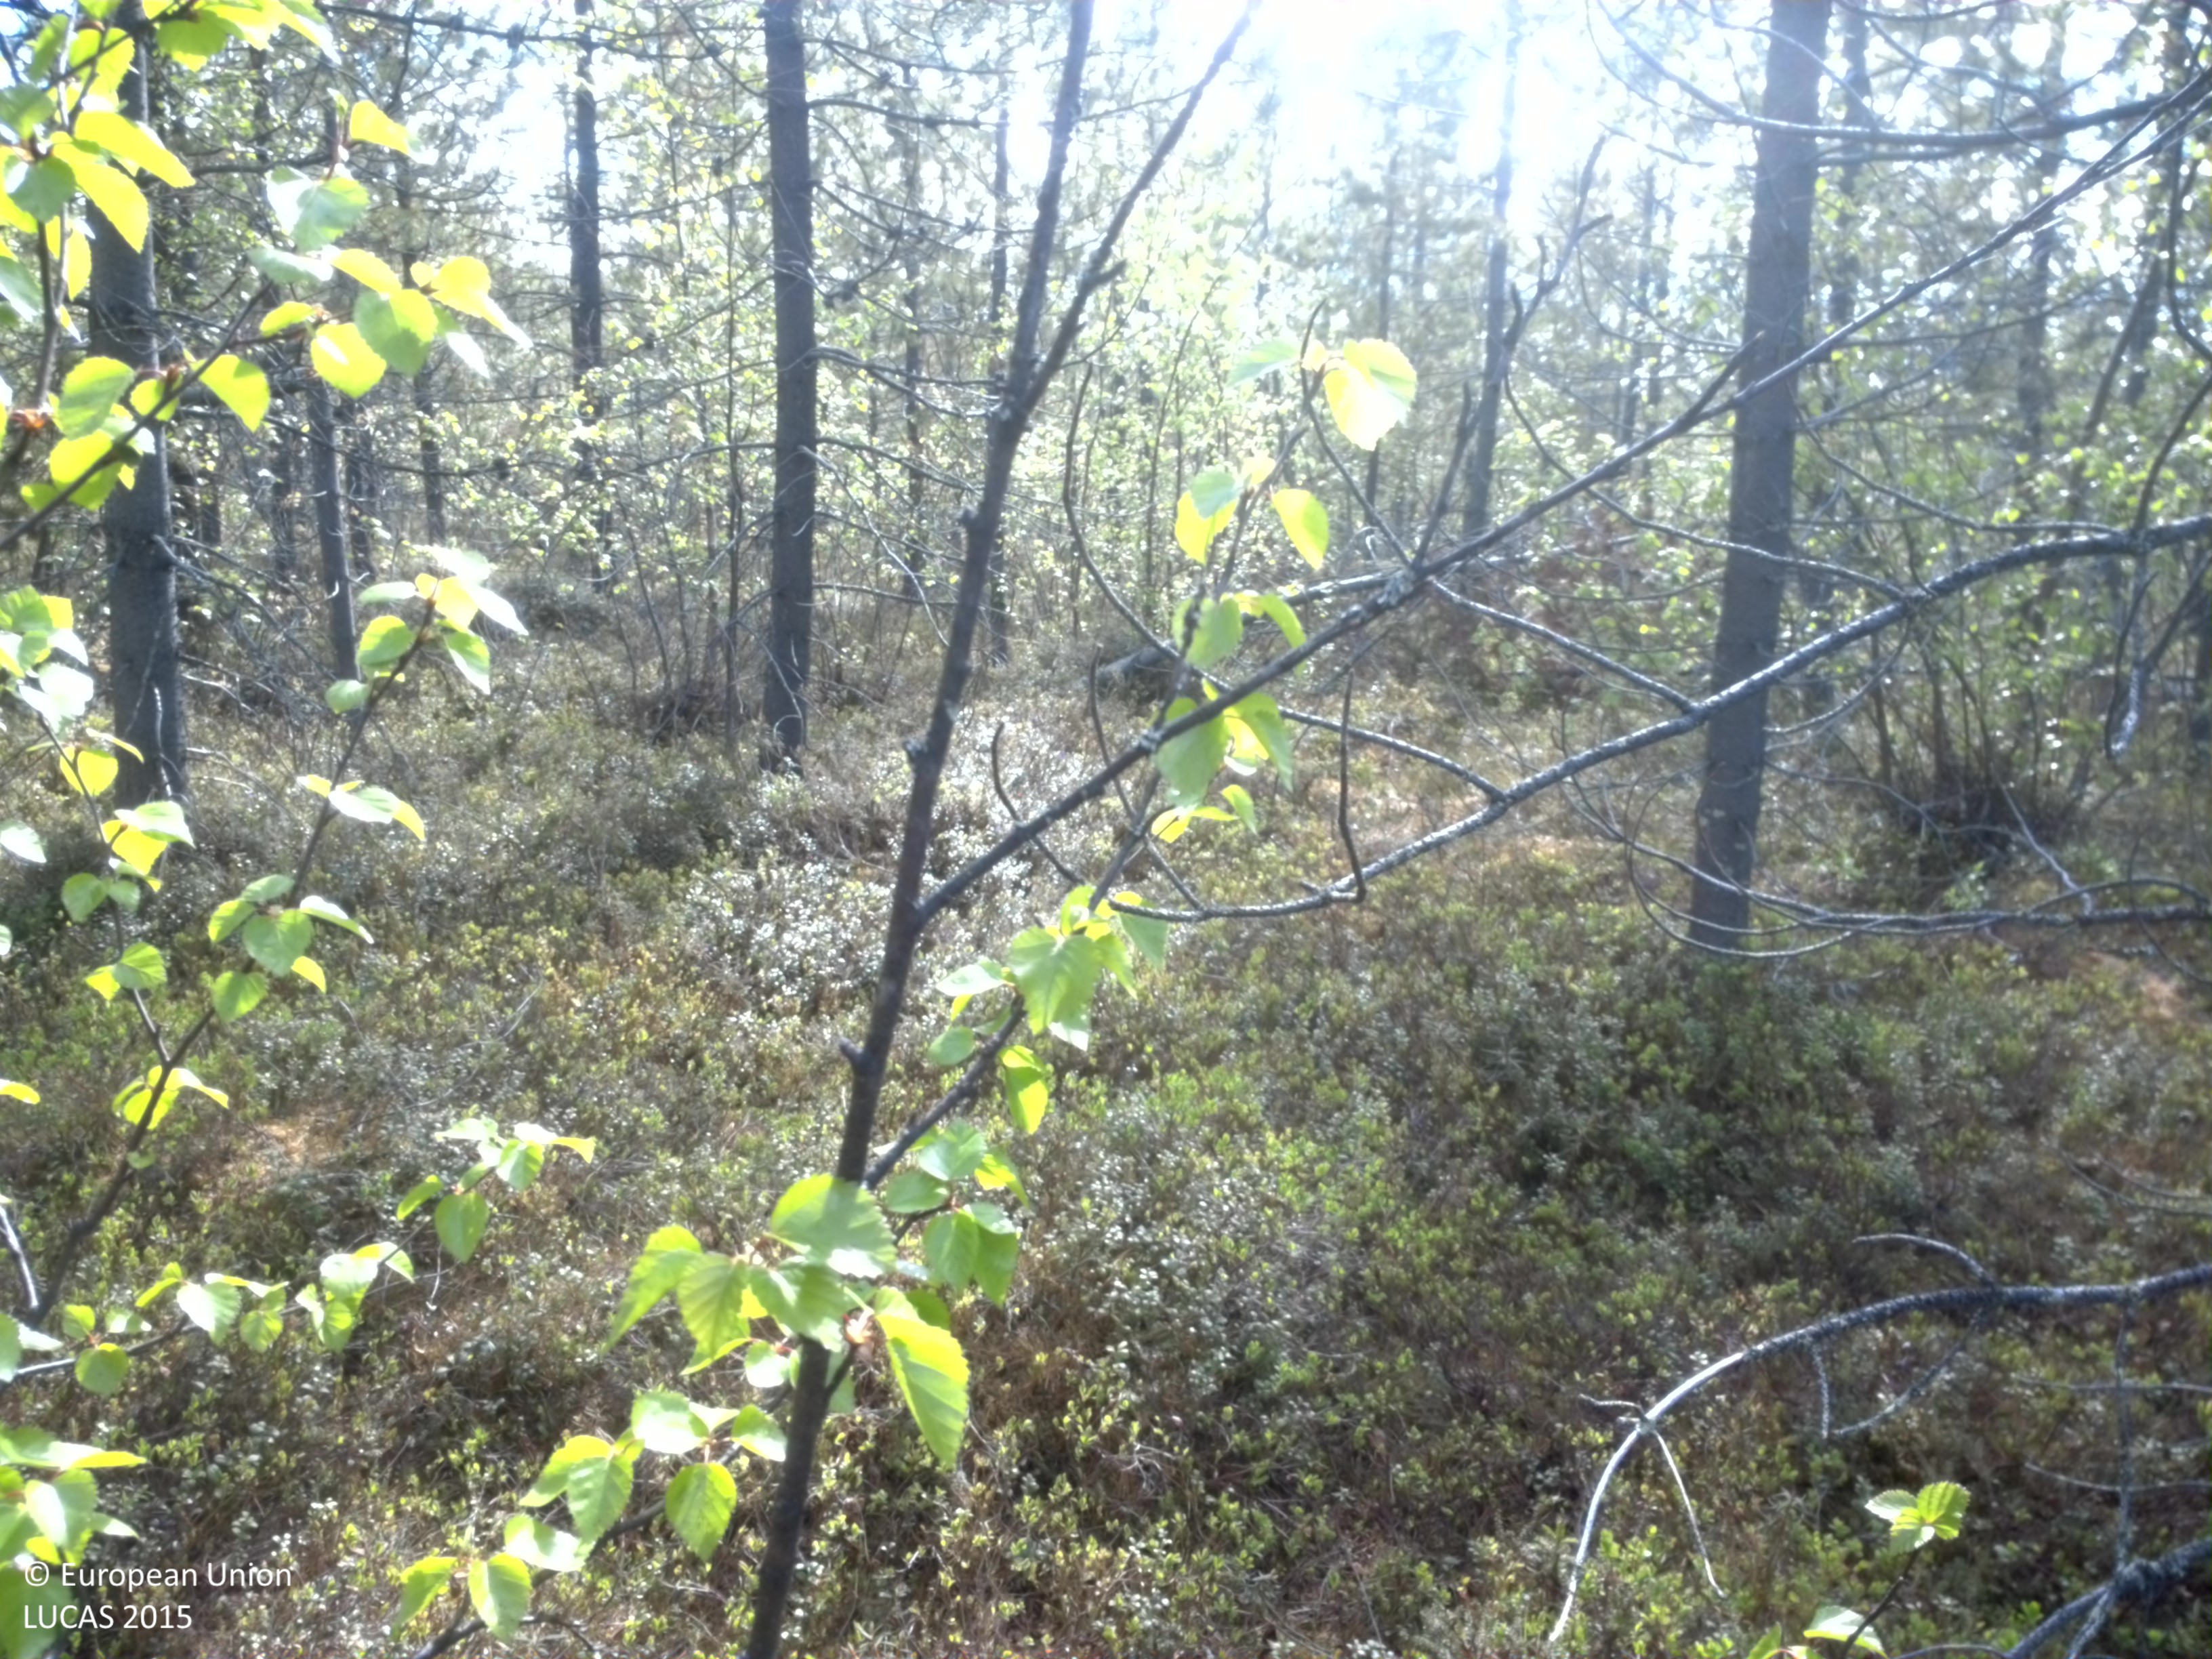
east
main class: Woodland
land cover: Pine dominated mixed woodland
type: boreal forest
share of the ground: 25 - 50 %
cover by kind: shrubs 60 %, coniferous forest trees 25 %, broadleaved forest trees 15 %
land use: Forestry
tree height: > 5 m
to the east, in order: Pine dominated mixed woodland; Shrubland with sparse tree cover; Spruce dominated mixed woodland; Other mixed woodland; Pine dominated mixed woodland
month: June
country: SE
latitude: 67.0041
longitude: 21.7253
